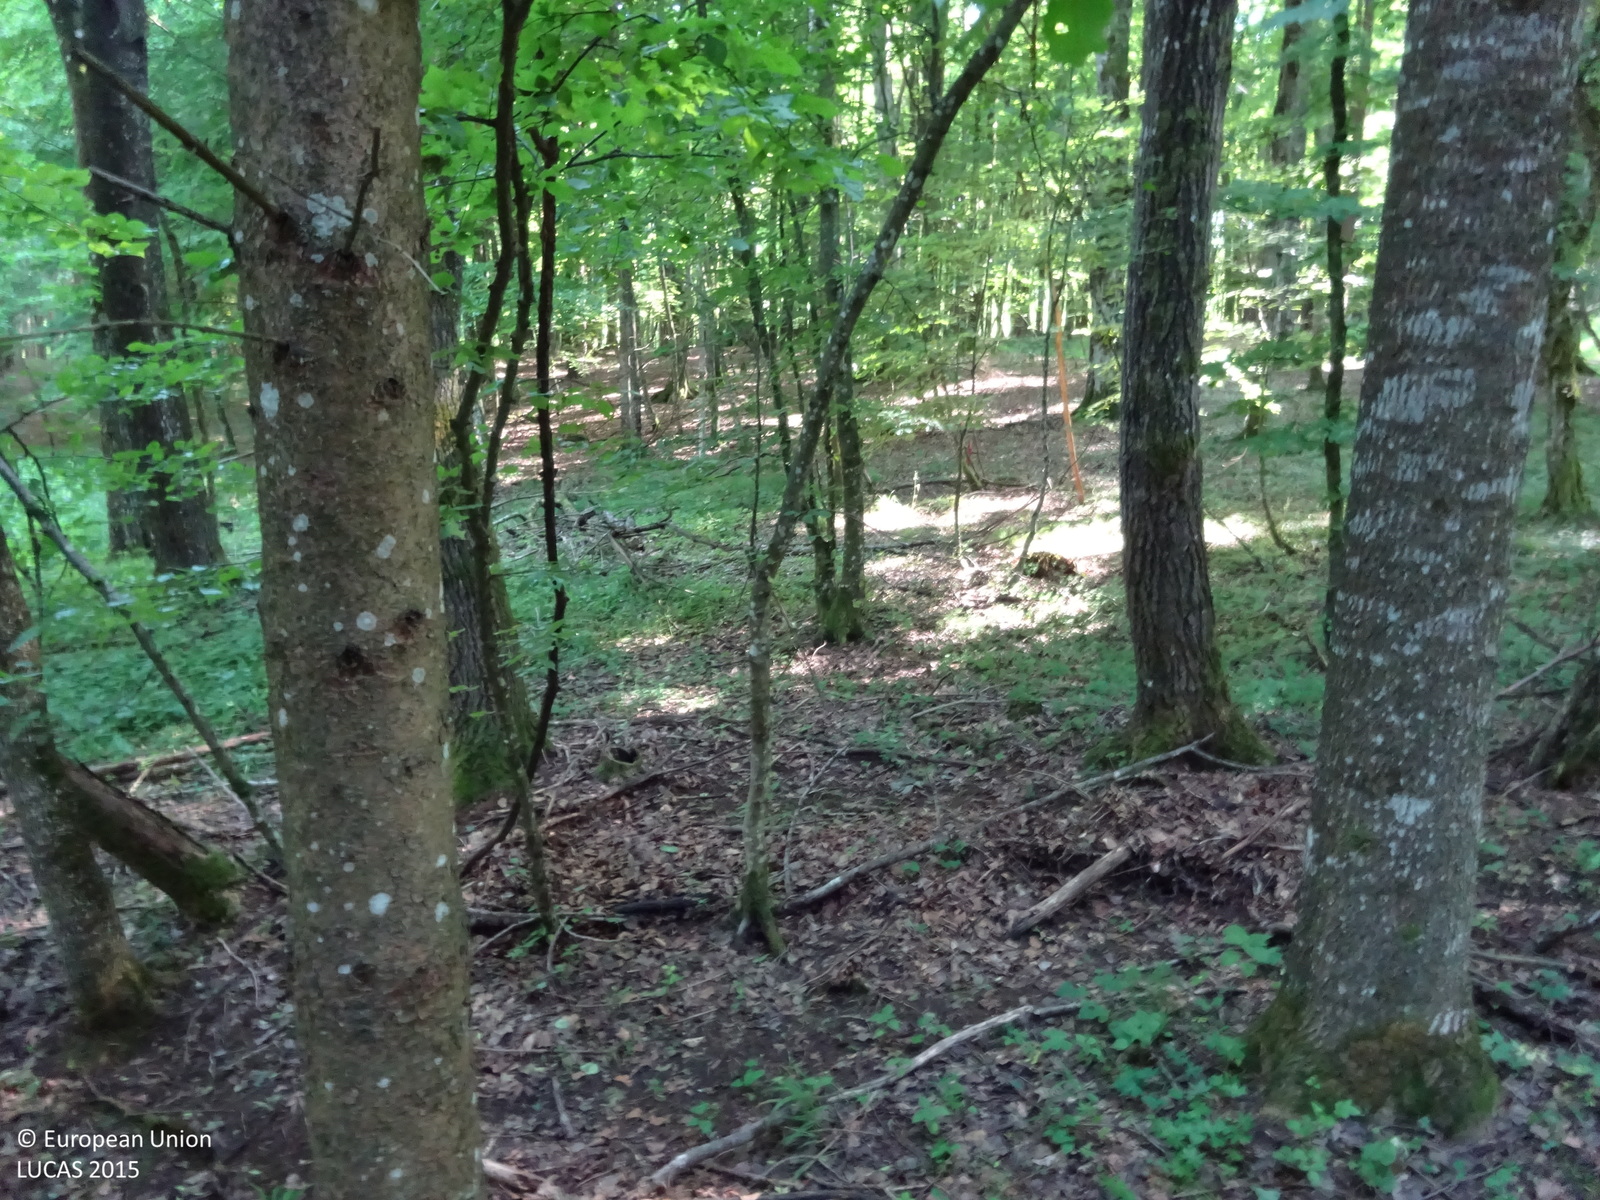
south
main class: Woodland
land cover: Broadleaved woodland
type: mountainous beech forest
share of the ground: > 75 %
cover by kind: broadleaved forest trees 85 %, coniferous forest trees 10 %, herbaceous plants 5 %
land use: Forestry
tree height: > 5 m
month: June
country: AT
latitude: 46.7974
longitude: 15.9880
